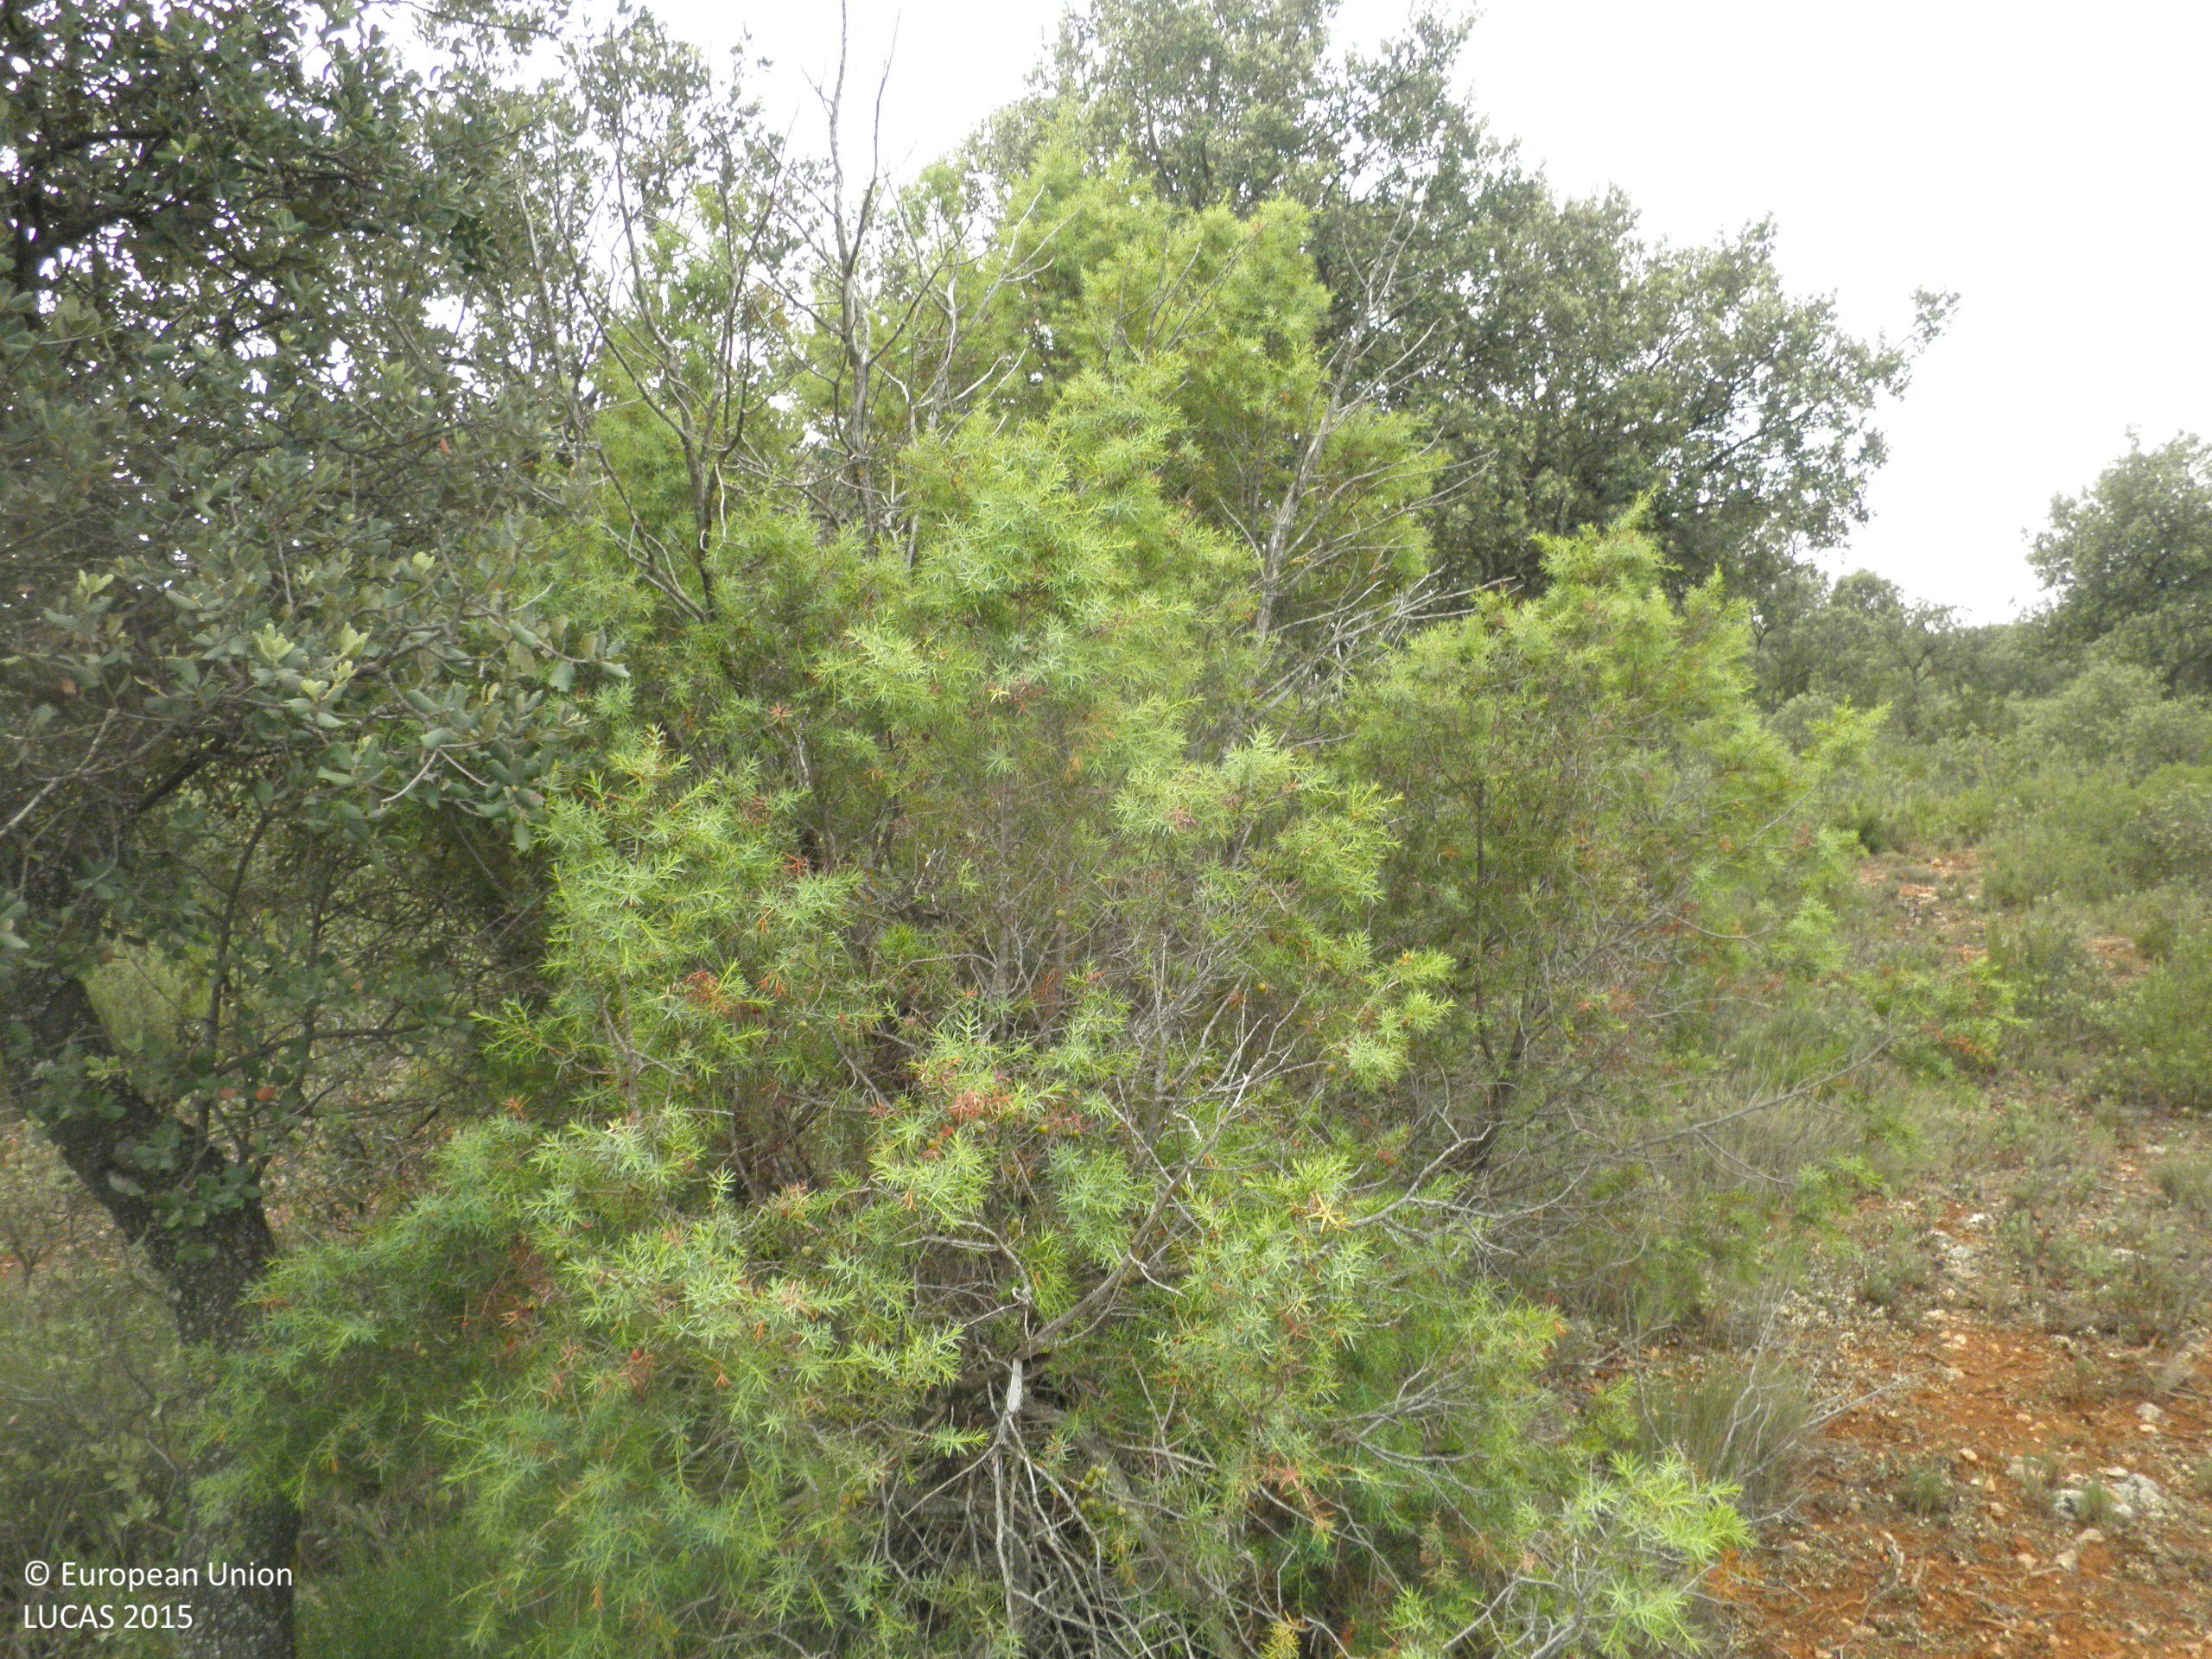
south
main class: Woodland
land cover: Broadleaved woodland
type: broadleaved evergreen forest
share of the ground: 25 - 50 %
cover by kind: shrubs 35 %, unconsolidated bare surface 30 %, broadleaved forest trees 25 %, herbaceous plants 10 %
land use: Semi-natural and natural areas not in use
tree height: < 5 m
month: June
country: ES
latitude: 39.5642
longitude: -1.7041
